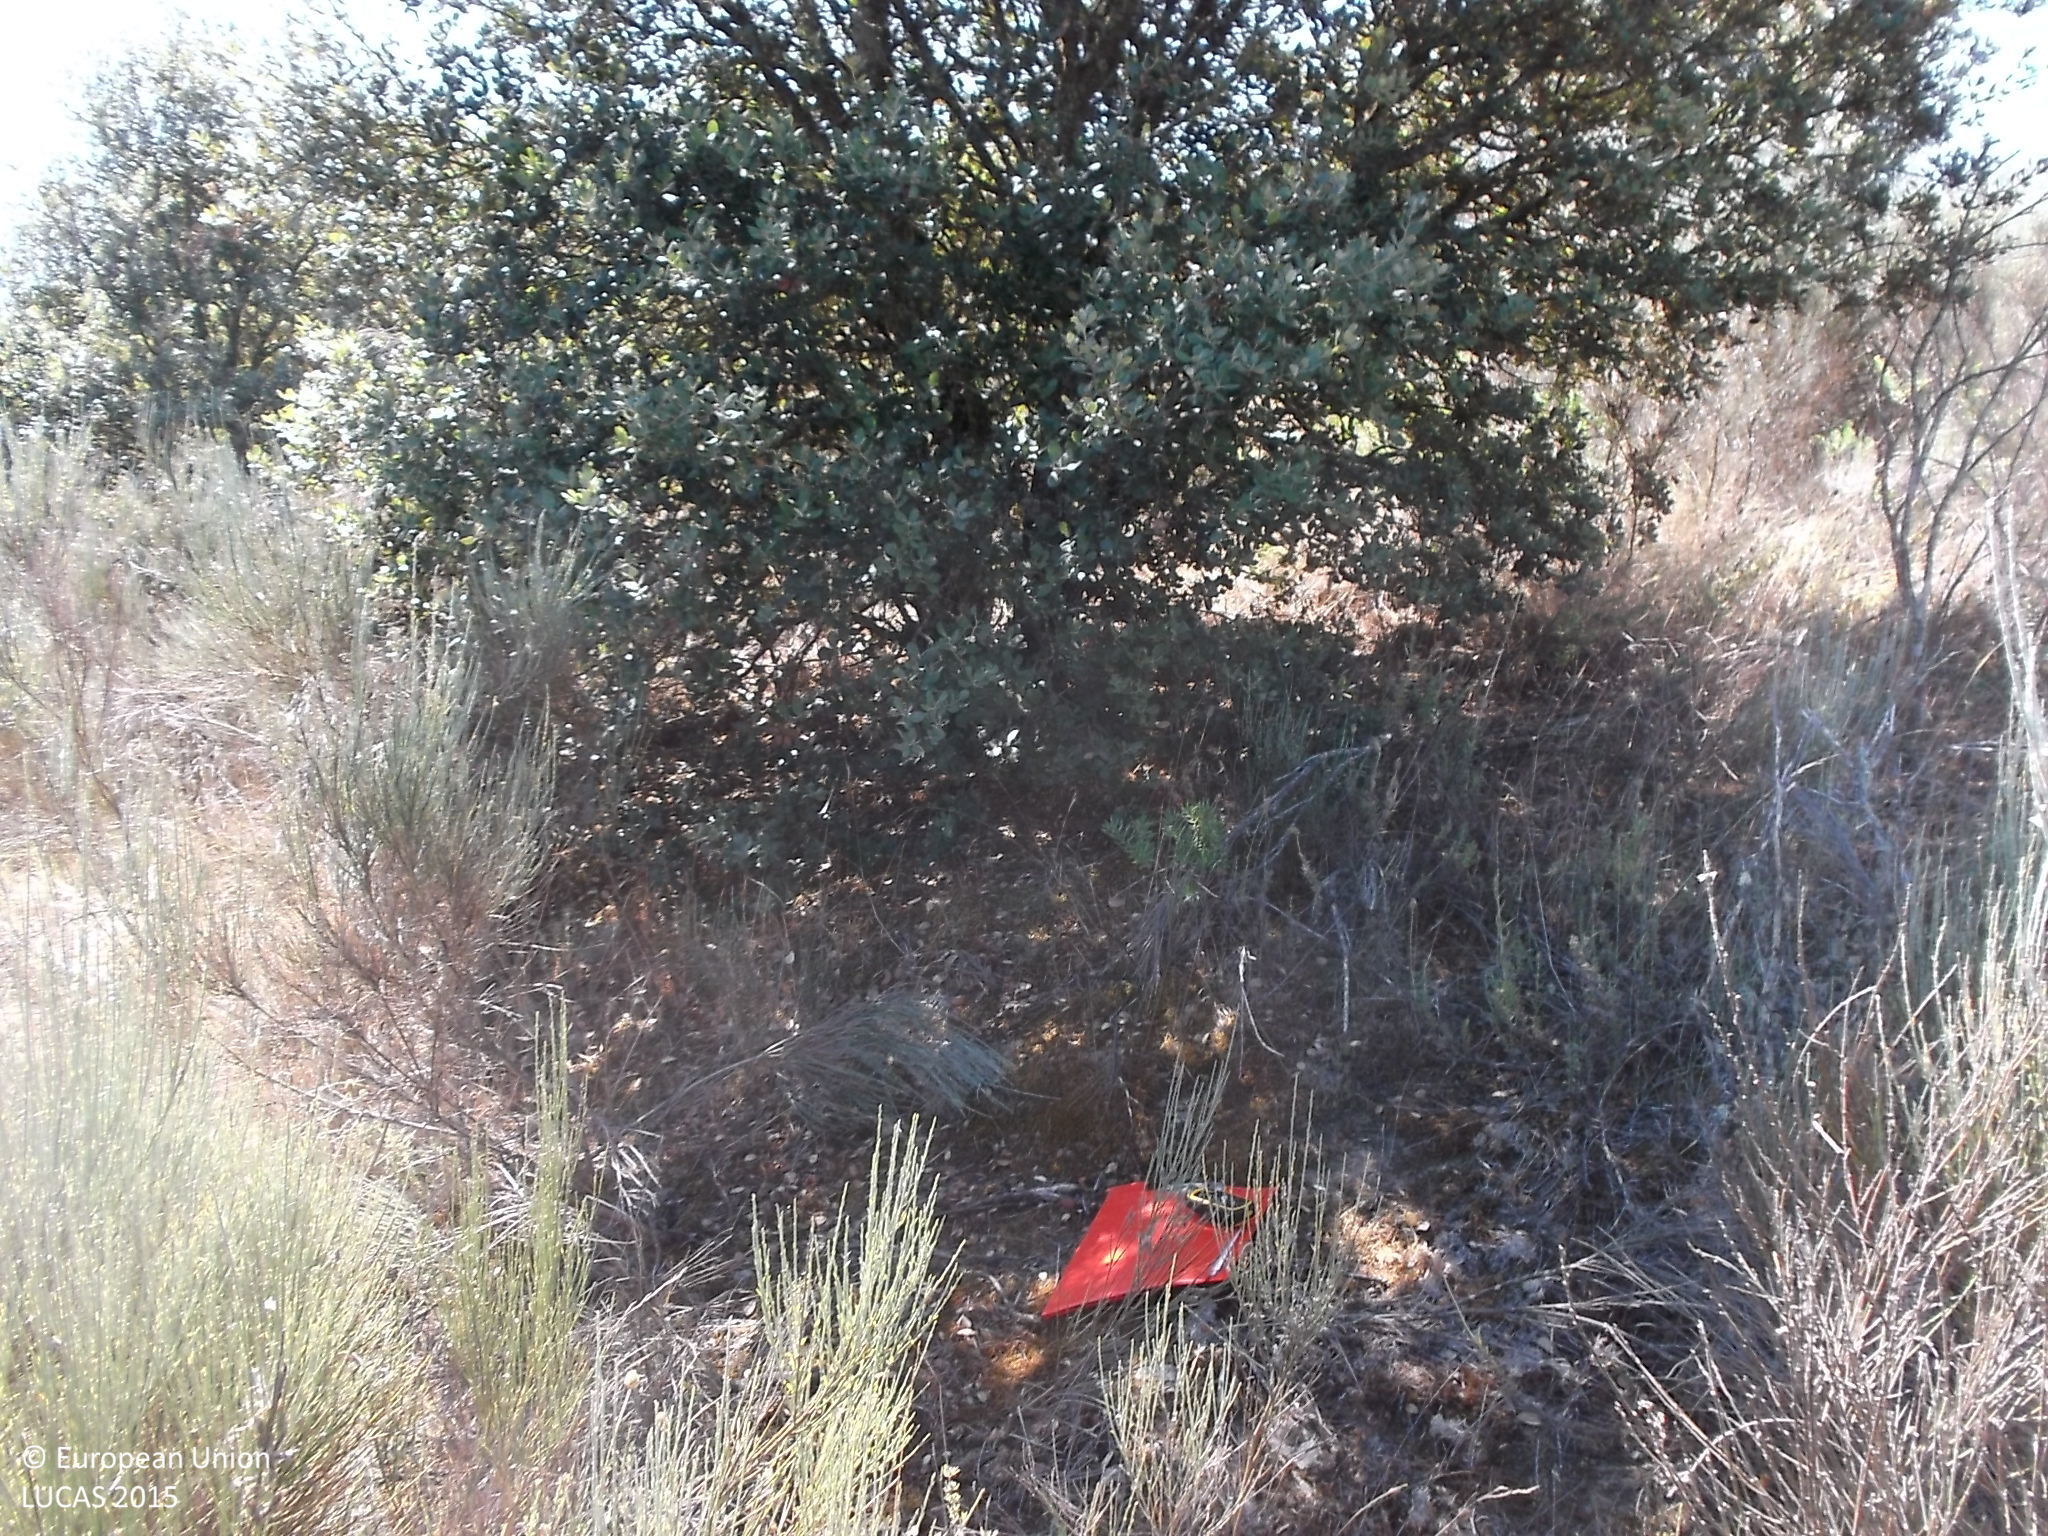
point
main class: Shrubland
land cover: Shrubland with sparse tree cover
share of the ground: > 75 %
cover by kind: shrubs 90 %, broadleaved forest trees 5 %, herbaceous plants 5 %
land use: Abandoned areas
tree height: < 5 m
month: June
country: ES
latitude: 40.8756
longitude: -6.7715
